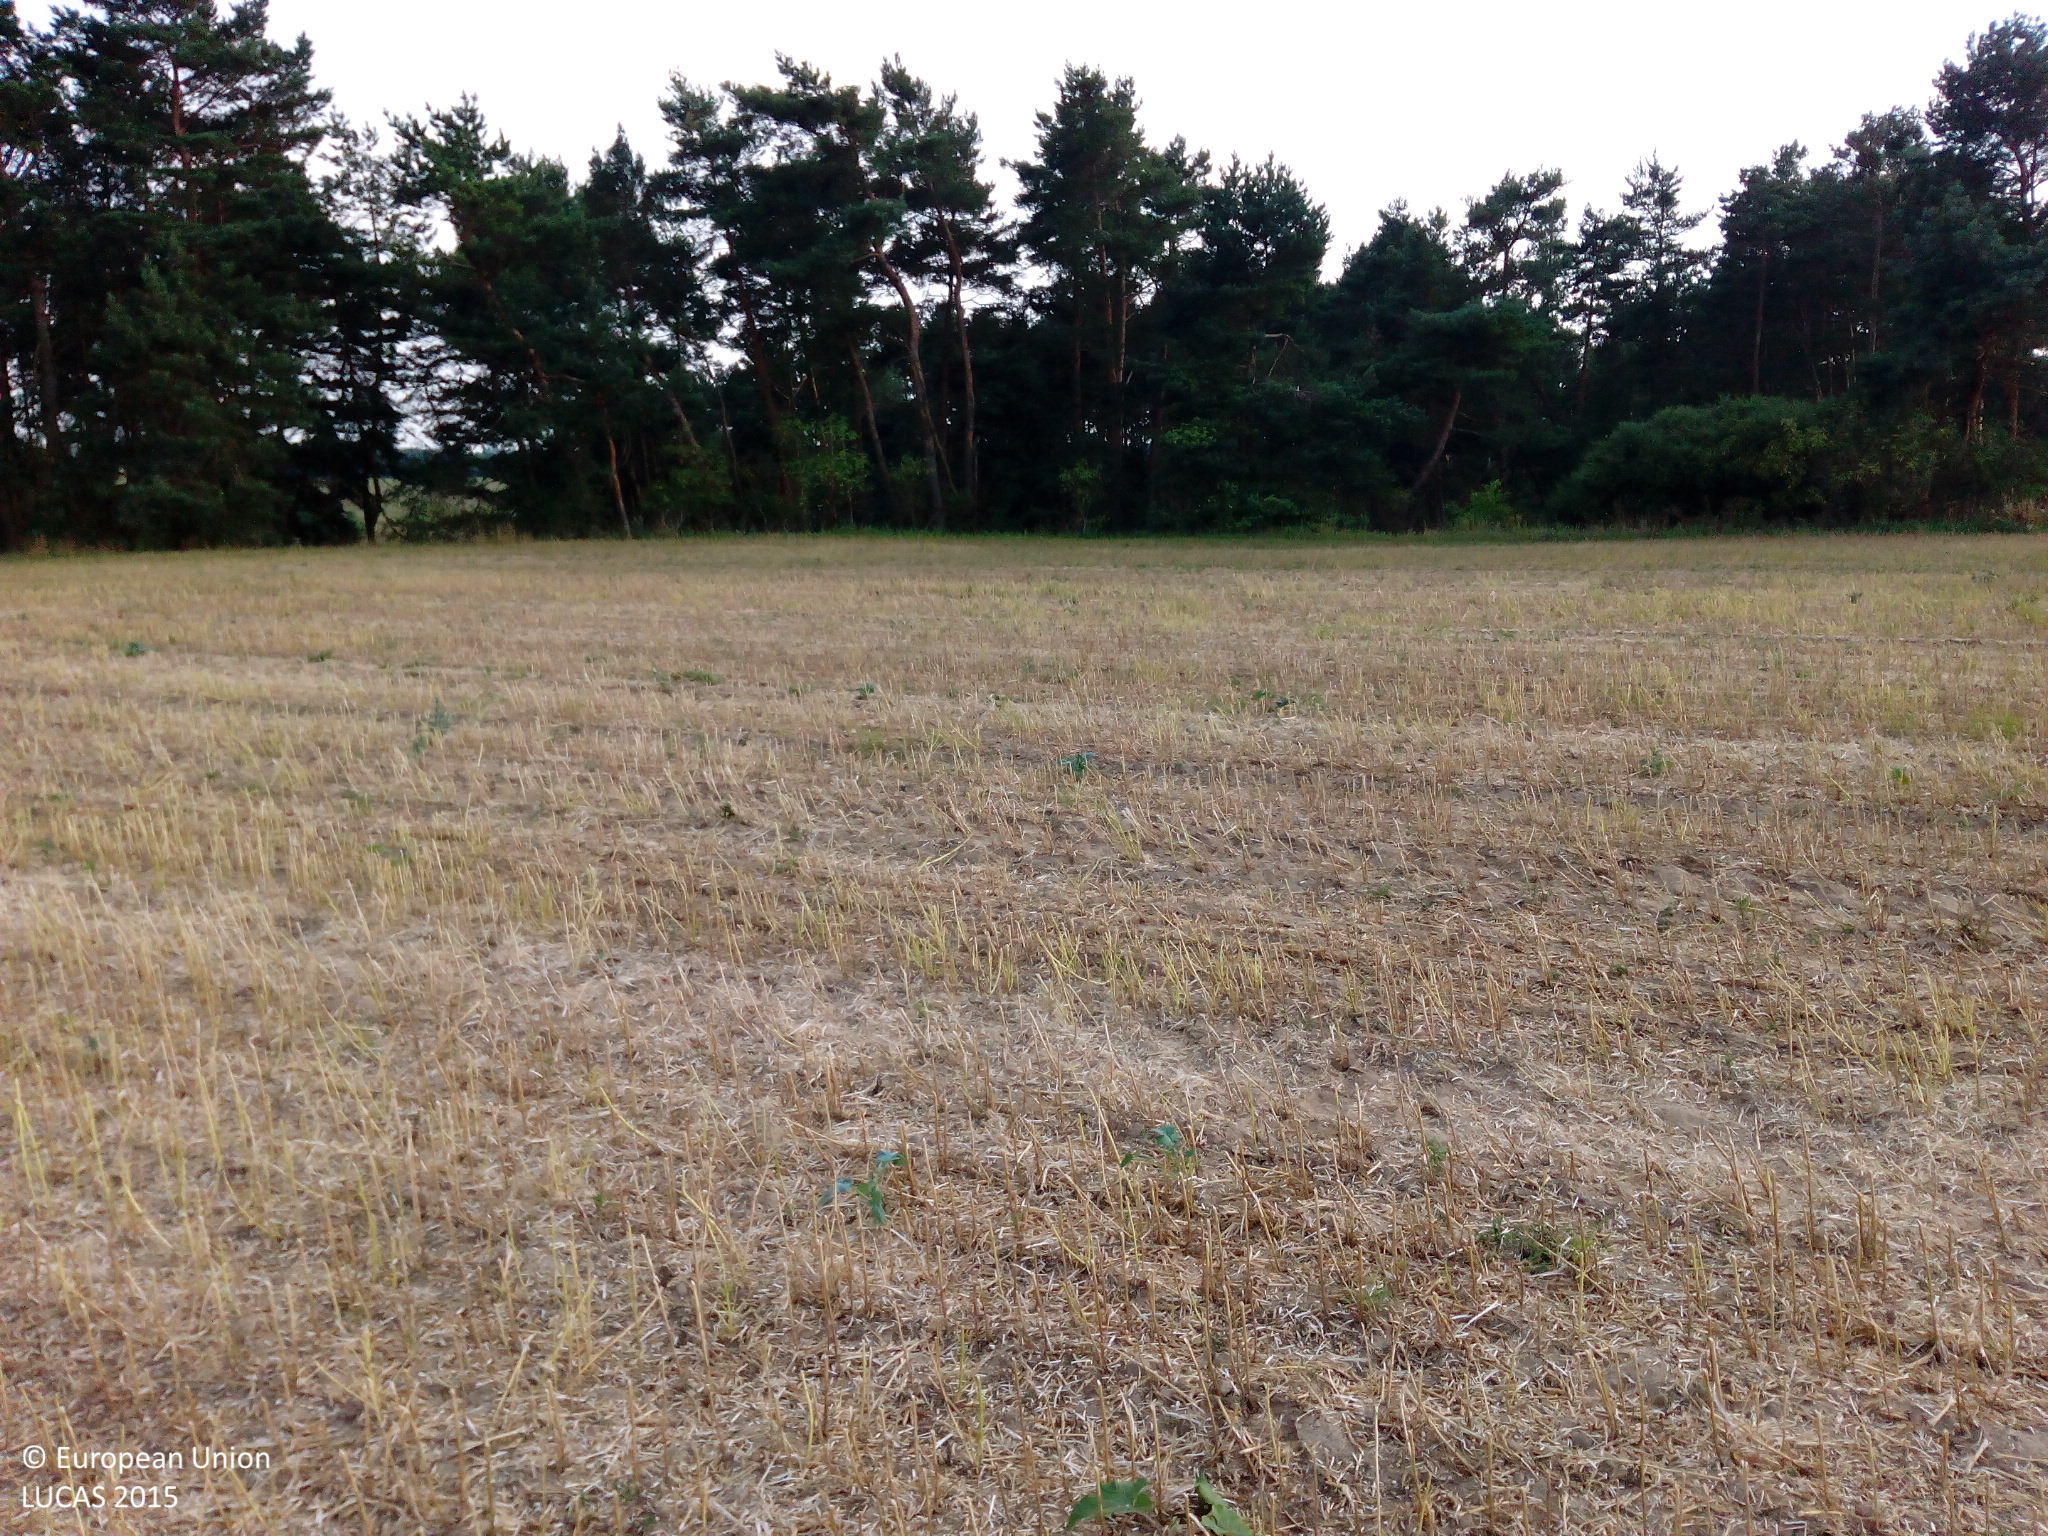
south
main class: Cropland
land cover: Dry pulses
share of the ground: < 10 %
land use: Agriculture (excluding fallow land and kitchen gardens)
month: August
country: DE
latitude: 52.6478
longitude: 14.1247
